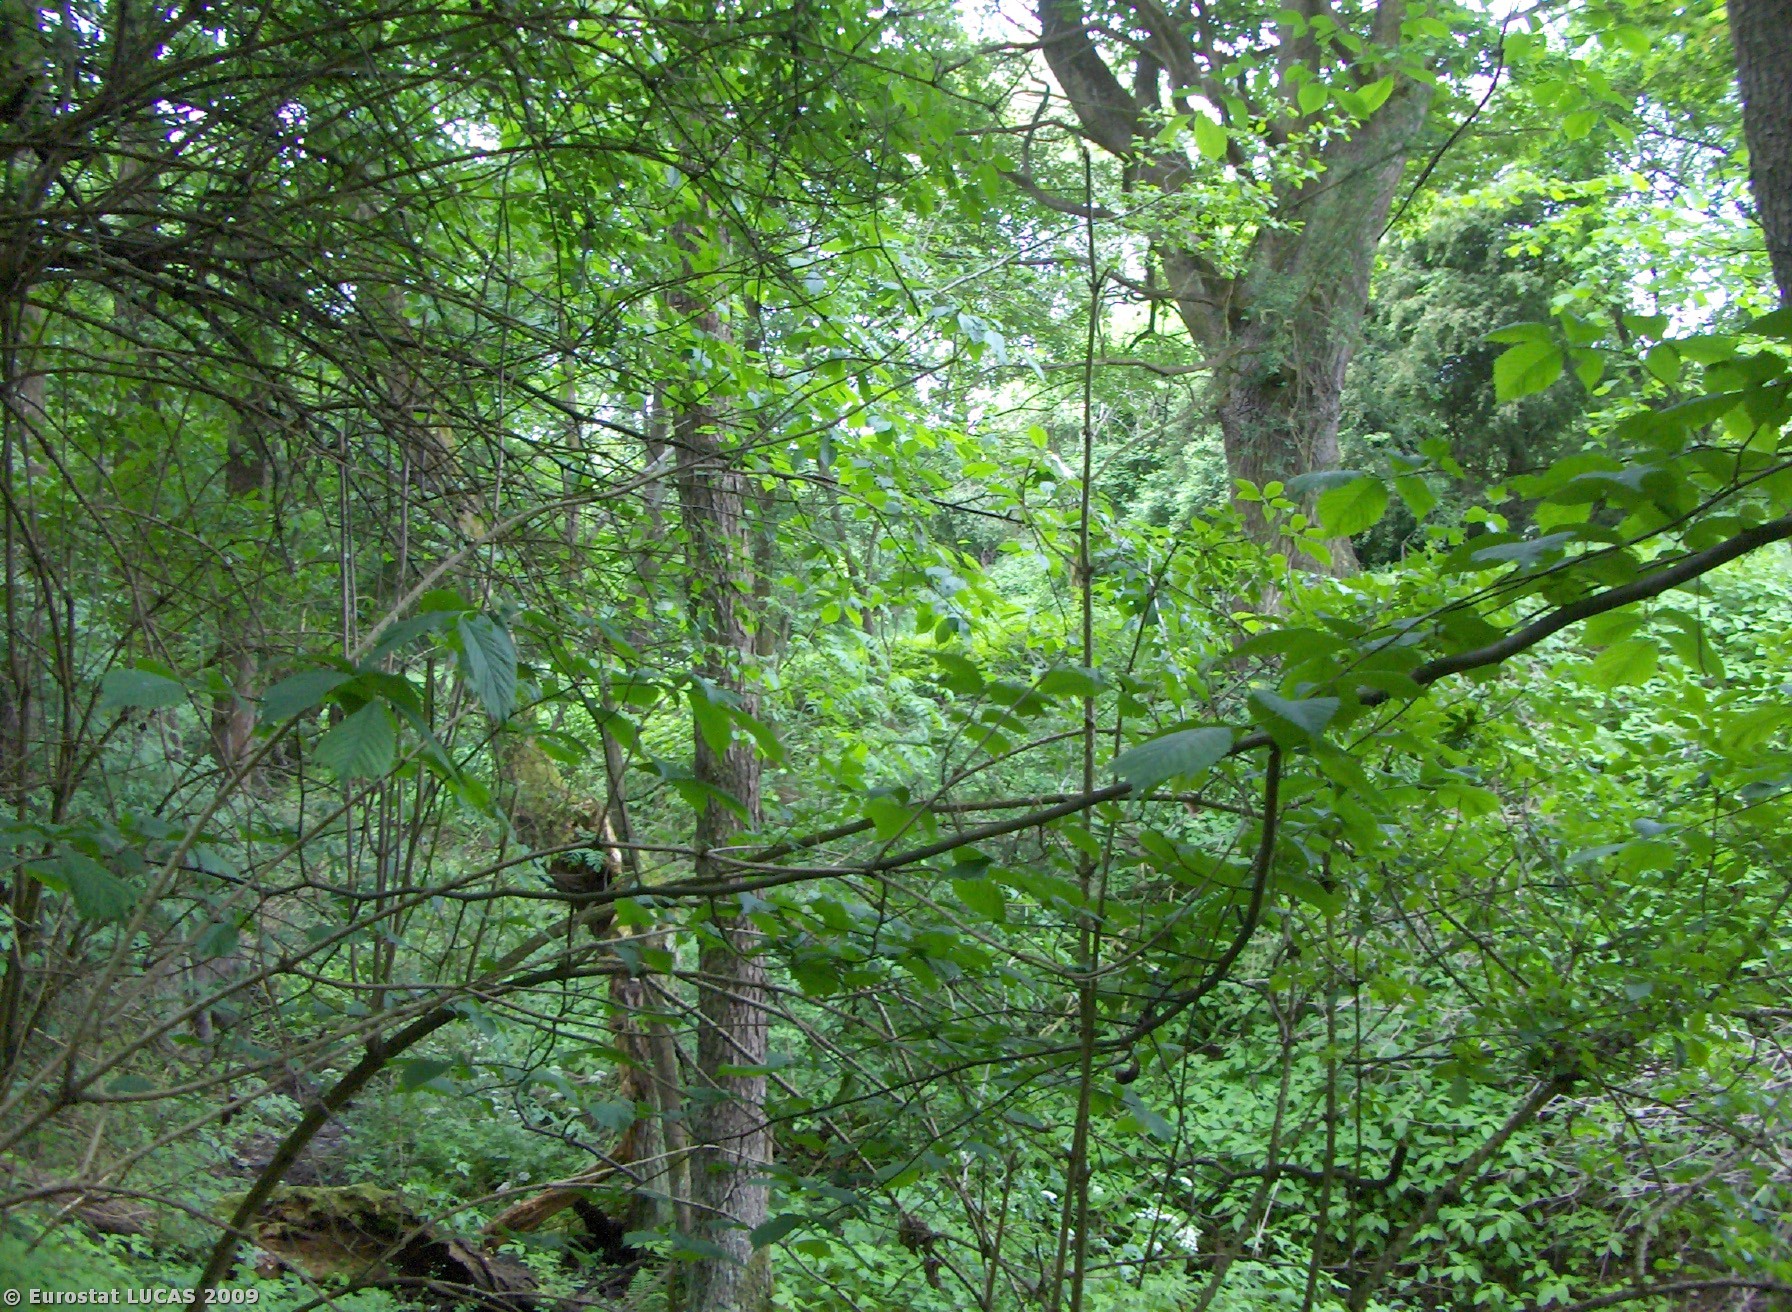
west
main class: Woodland
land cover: Broadleaved woodland
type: mesophytic deciduous forest
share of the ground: > 75 %
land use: Forestry
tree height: > 5 m
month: May
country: CZ
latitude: 49.6146
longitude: 14.3610
